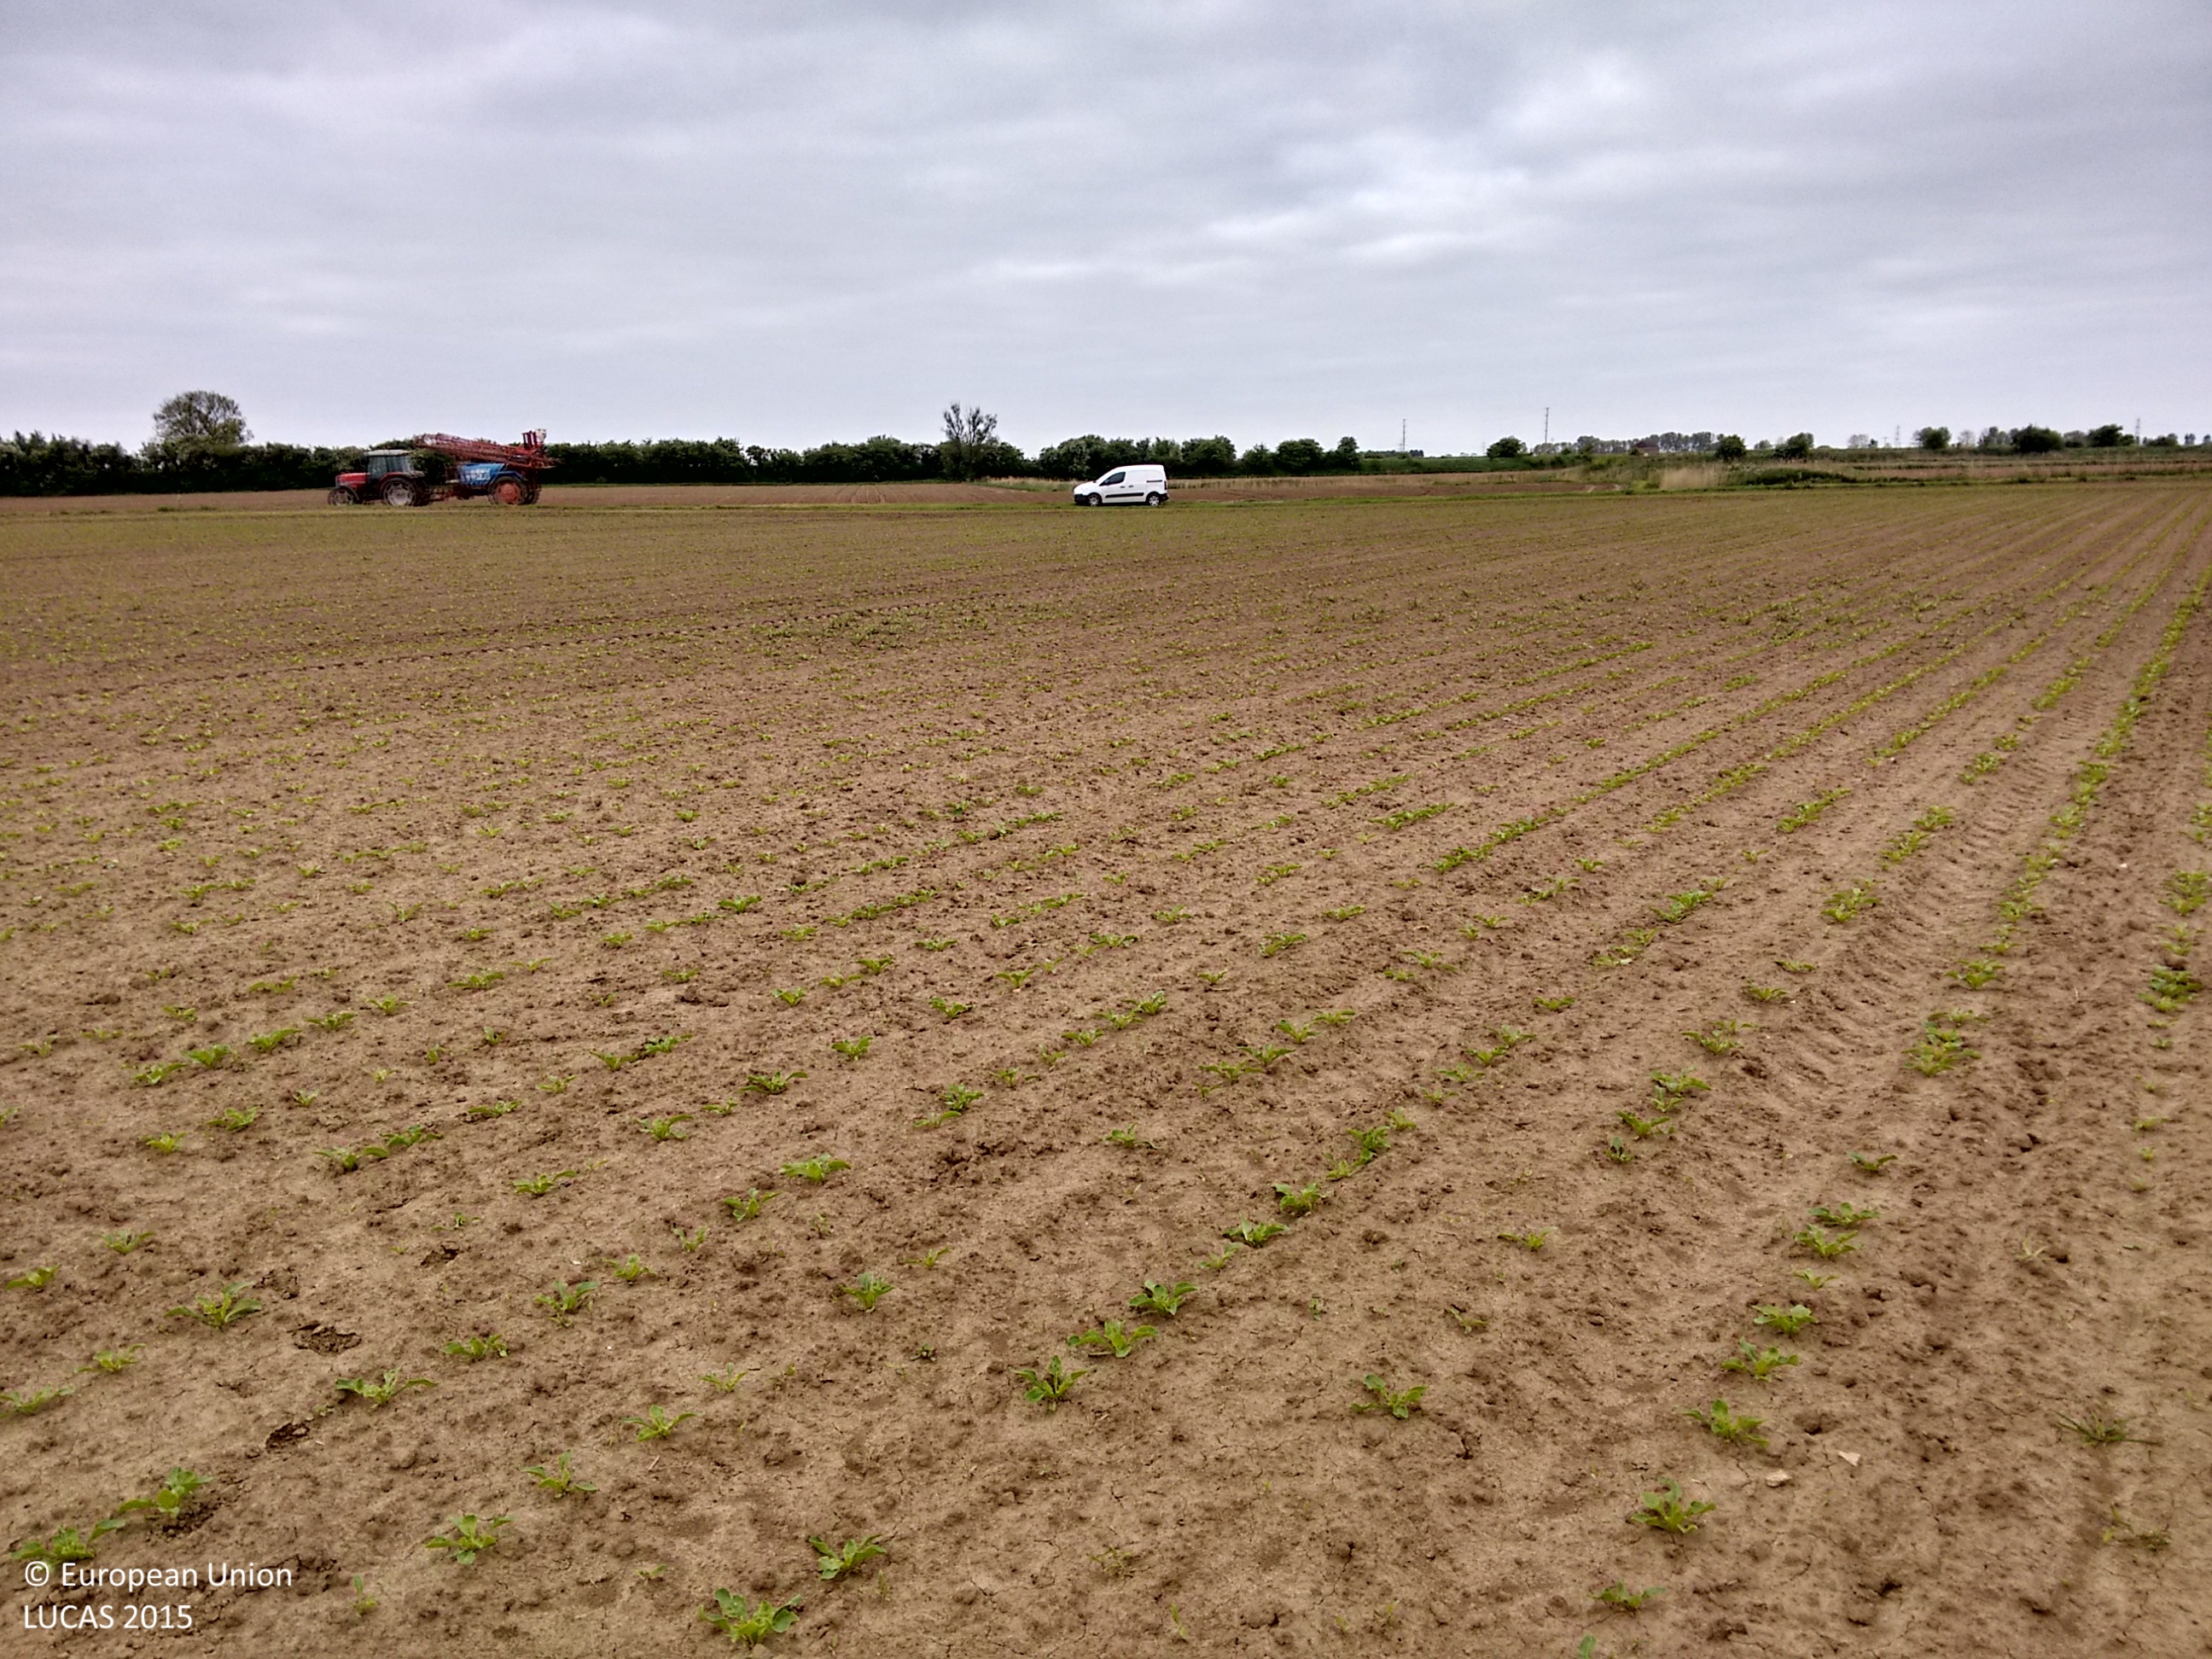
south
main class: Cropland
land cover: Other fresh vegetables
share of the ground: < 10 %
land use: Agriculture (excluding fallow land and kitchen gardens)
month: May
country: GB
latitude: 52.8731
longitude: -0.0614
